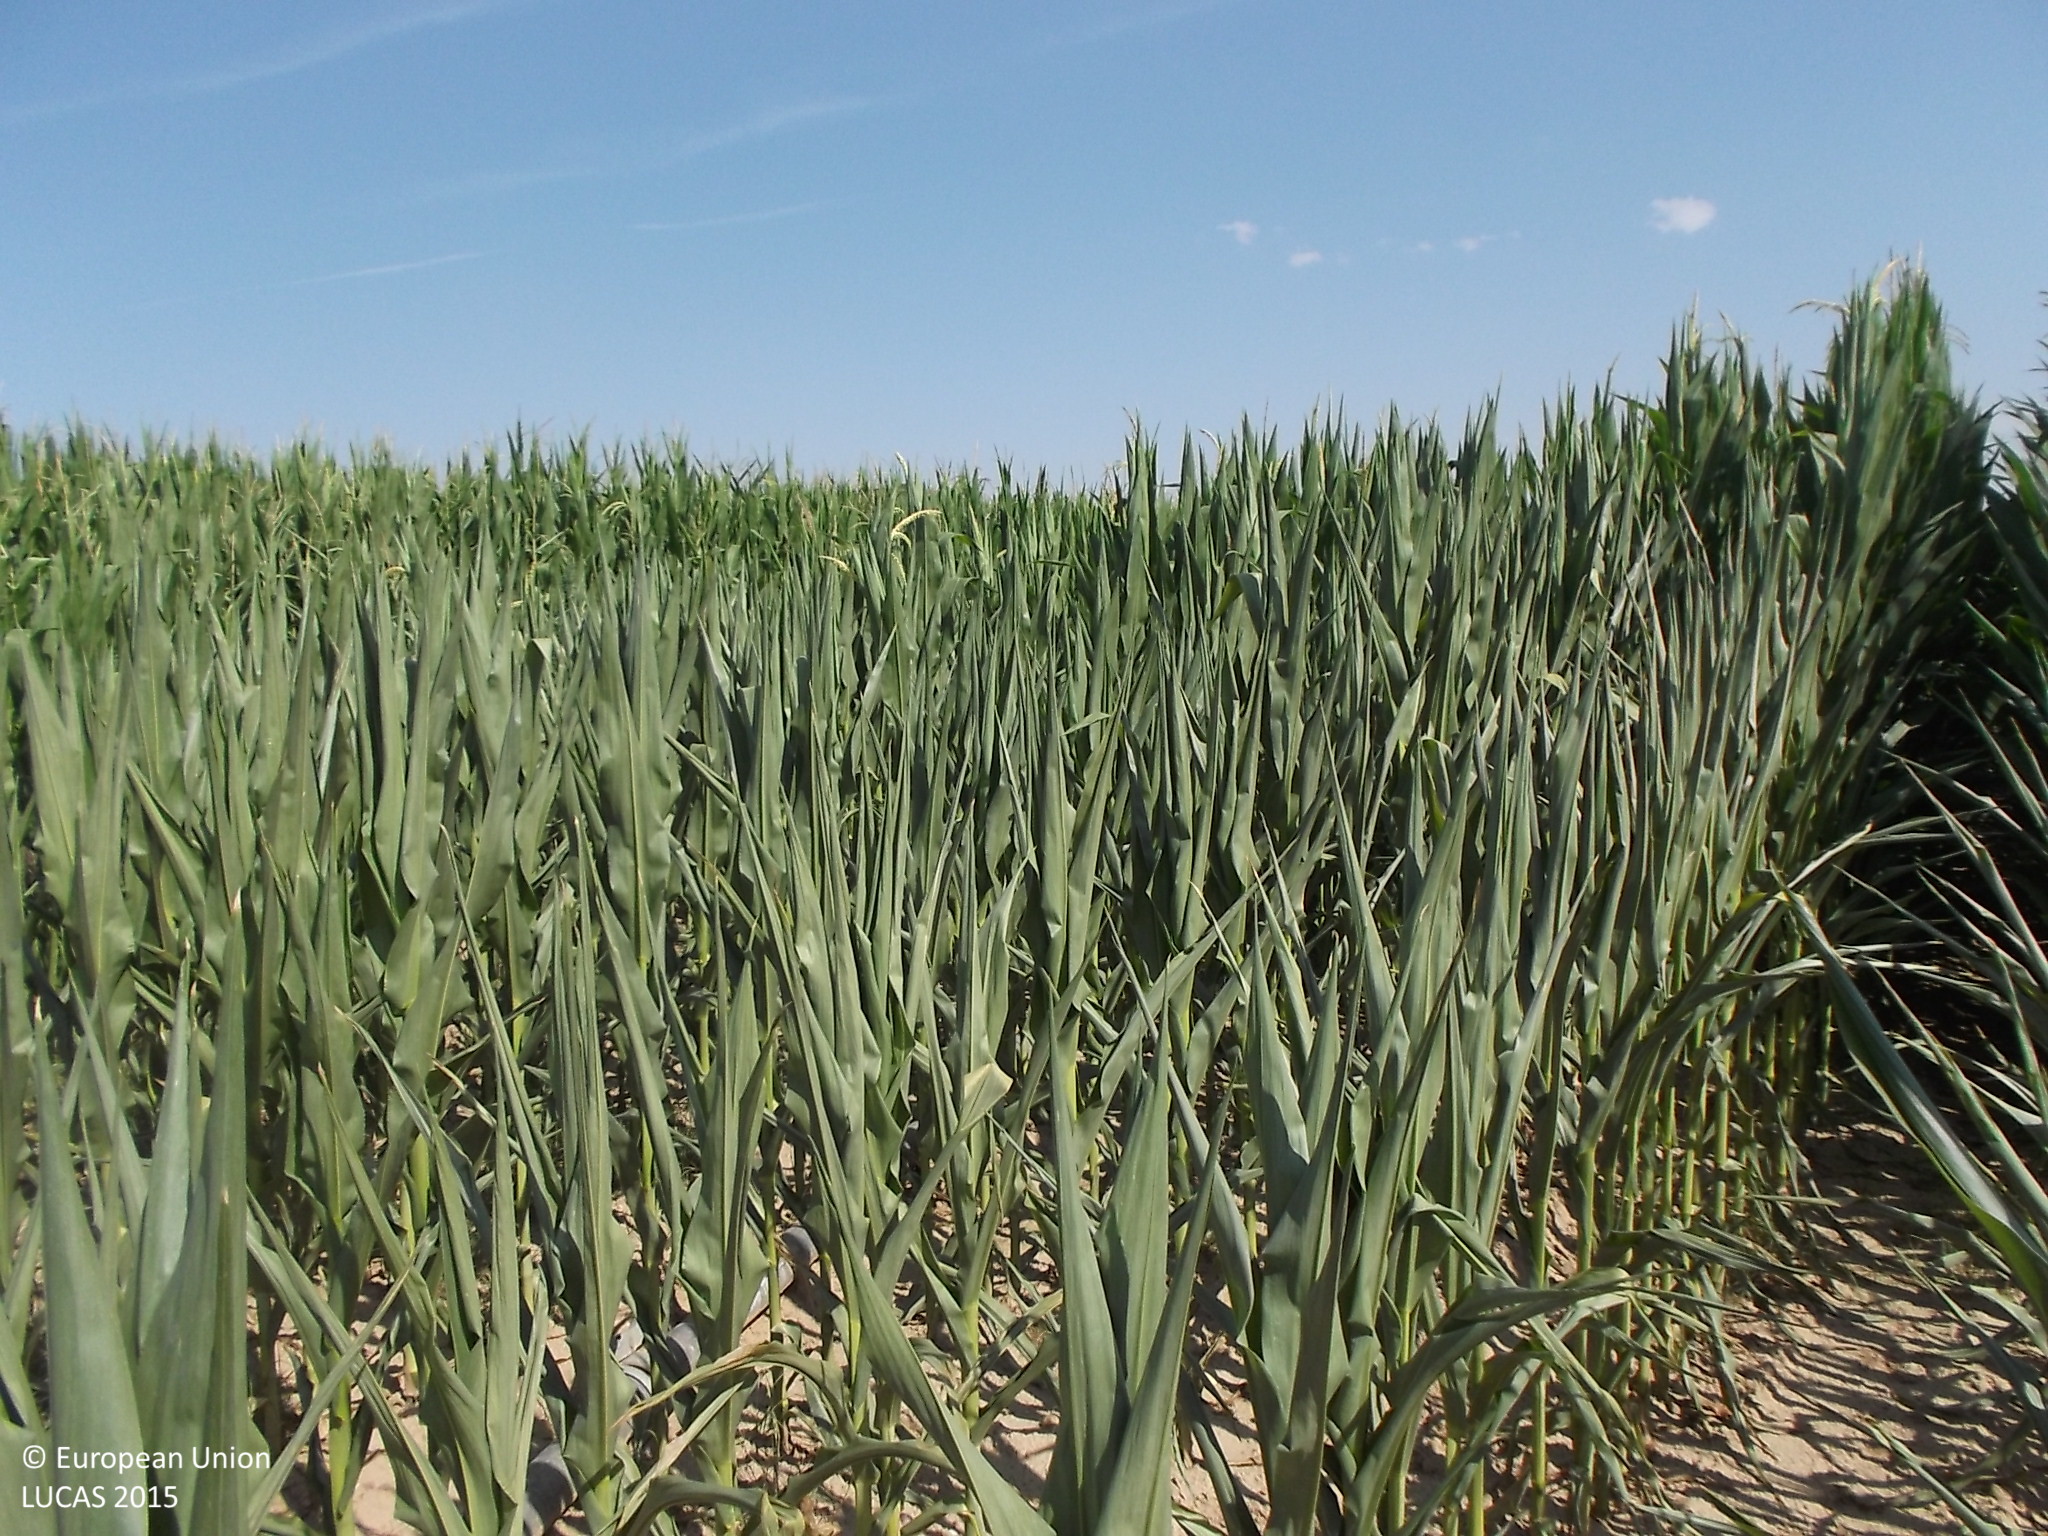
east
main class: Cropland
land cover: Maize
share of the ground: > 75 %
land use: Agriculture (excluding fallow land and kitchen gardens)
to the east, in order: Maize; Grass margins; Maize
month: July
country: ES
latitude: 41.4484
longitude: -5.2906
